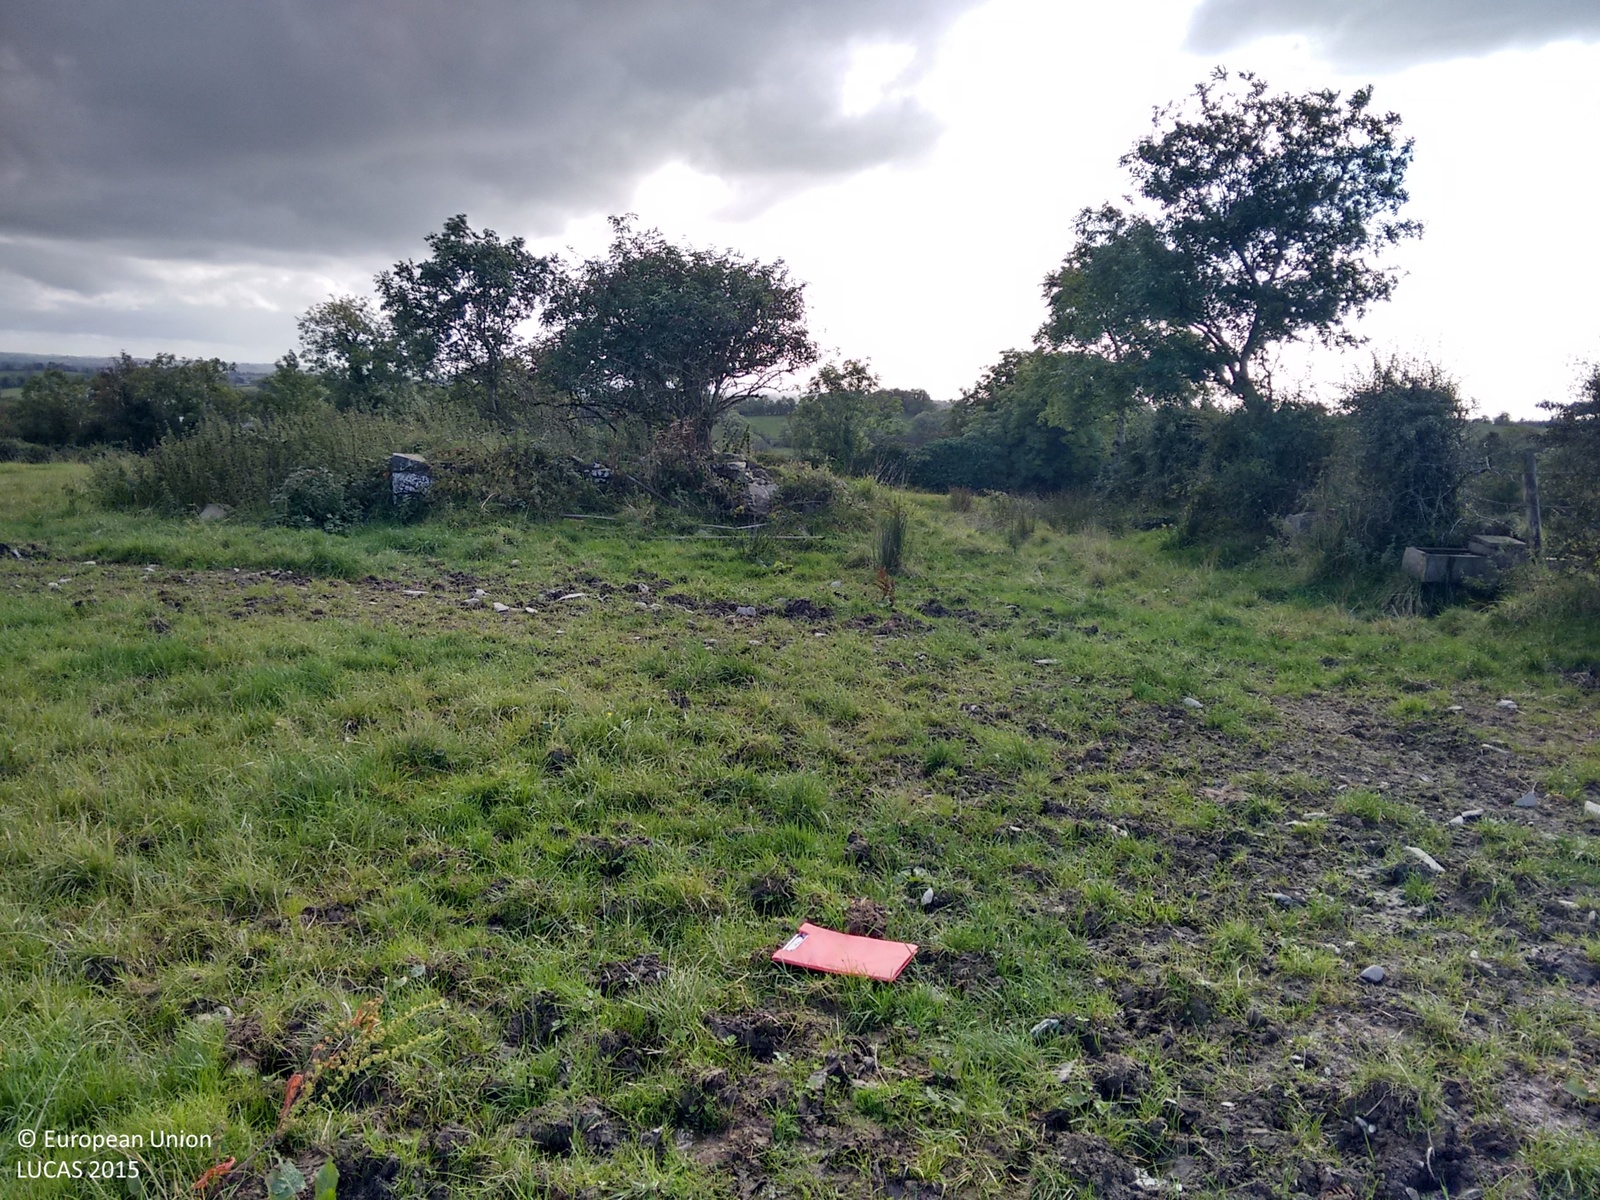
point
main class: Grassland
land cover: Grassland without tree/shrub cover
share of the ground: > 75 %
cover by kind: herbaceous plants 100 %
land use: Agriculture (excluding fallow land and kitchen gardens)
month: September
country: IE
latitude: 54.1778
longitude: -6.9776
